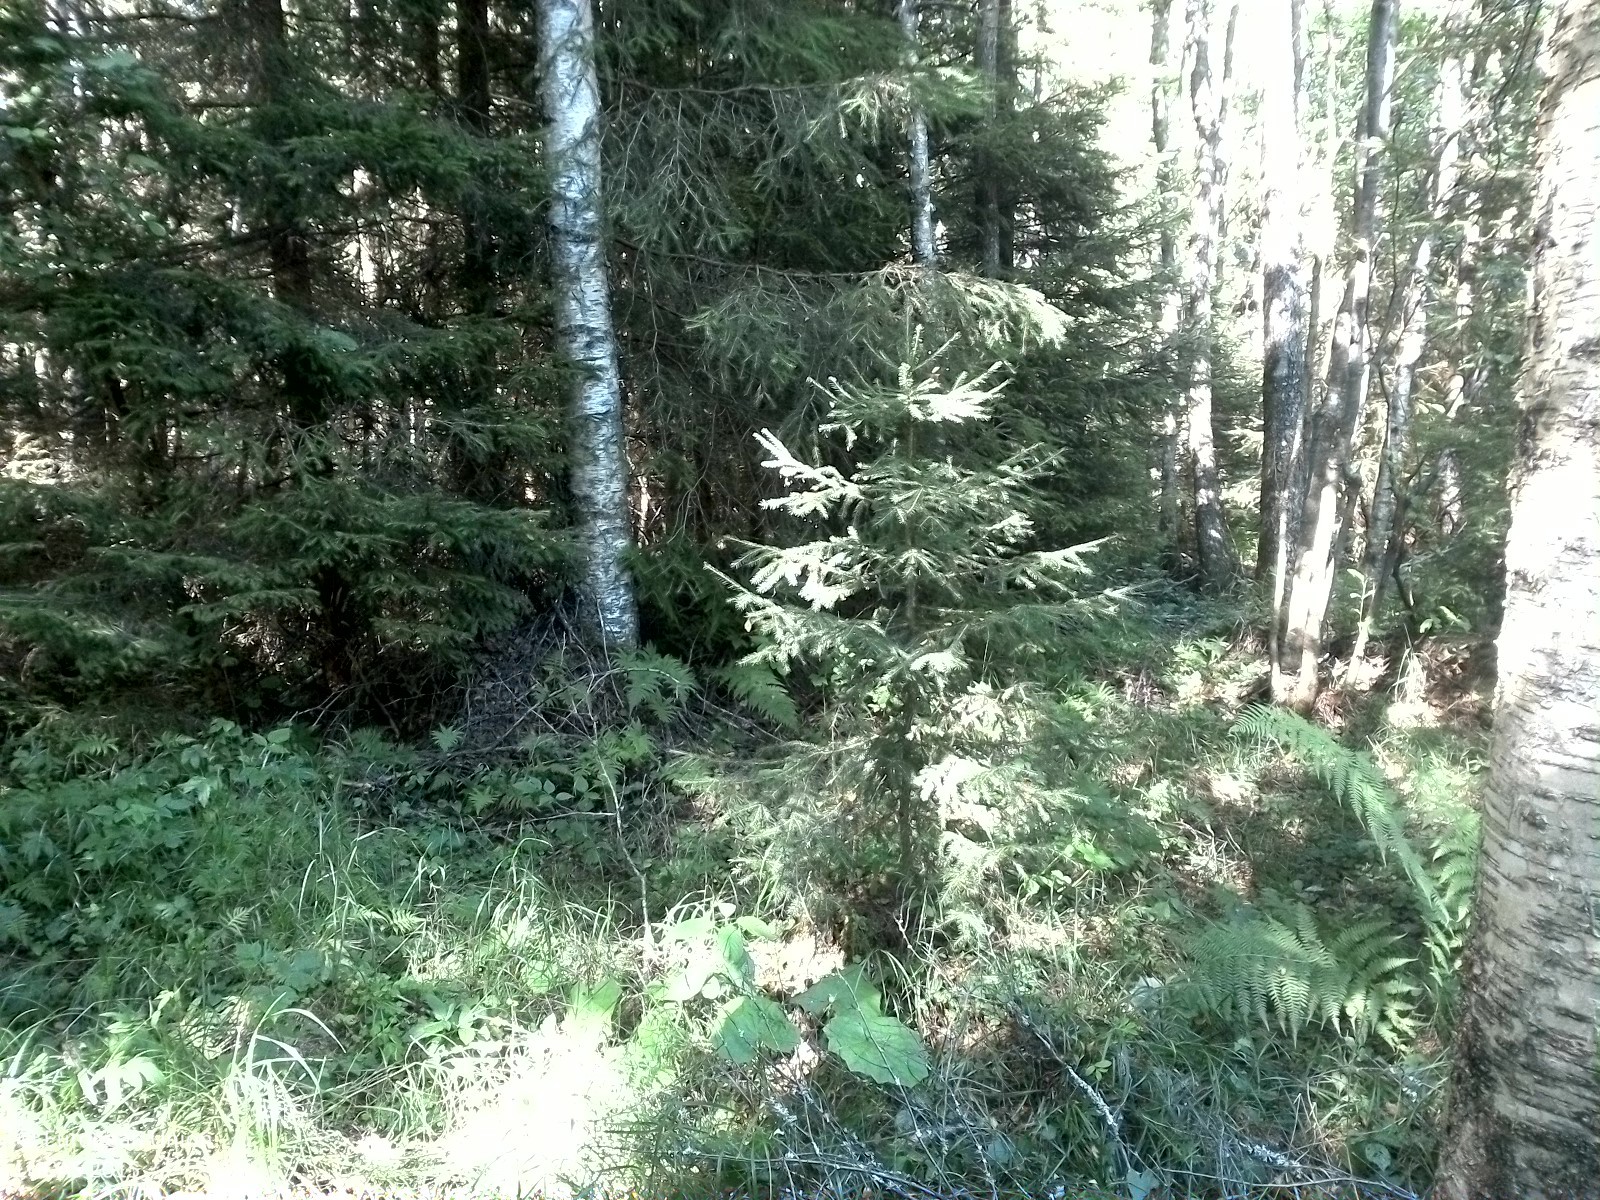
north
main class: Woodland
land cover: Spruce dominated mixed woodland
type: boreal forest
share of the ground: 50 - 75 %
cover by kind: shrubs 45 %, coniferous forest trees 30 %, broadleaved forest trees 25 %
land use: Forestry
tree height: > 5 m
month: August
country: SE
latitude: 59.2318
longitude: 14.8462
